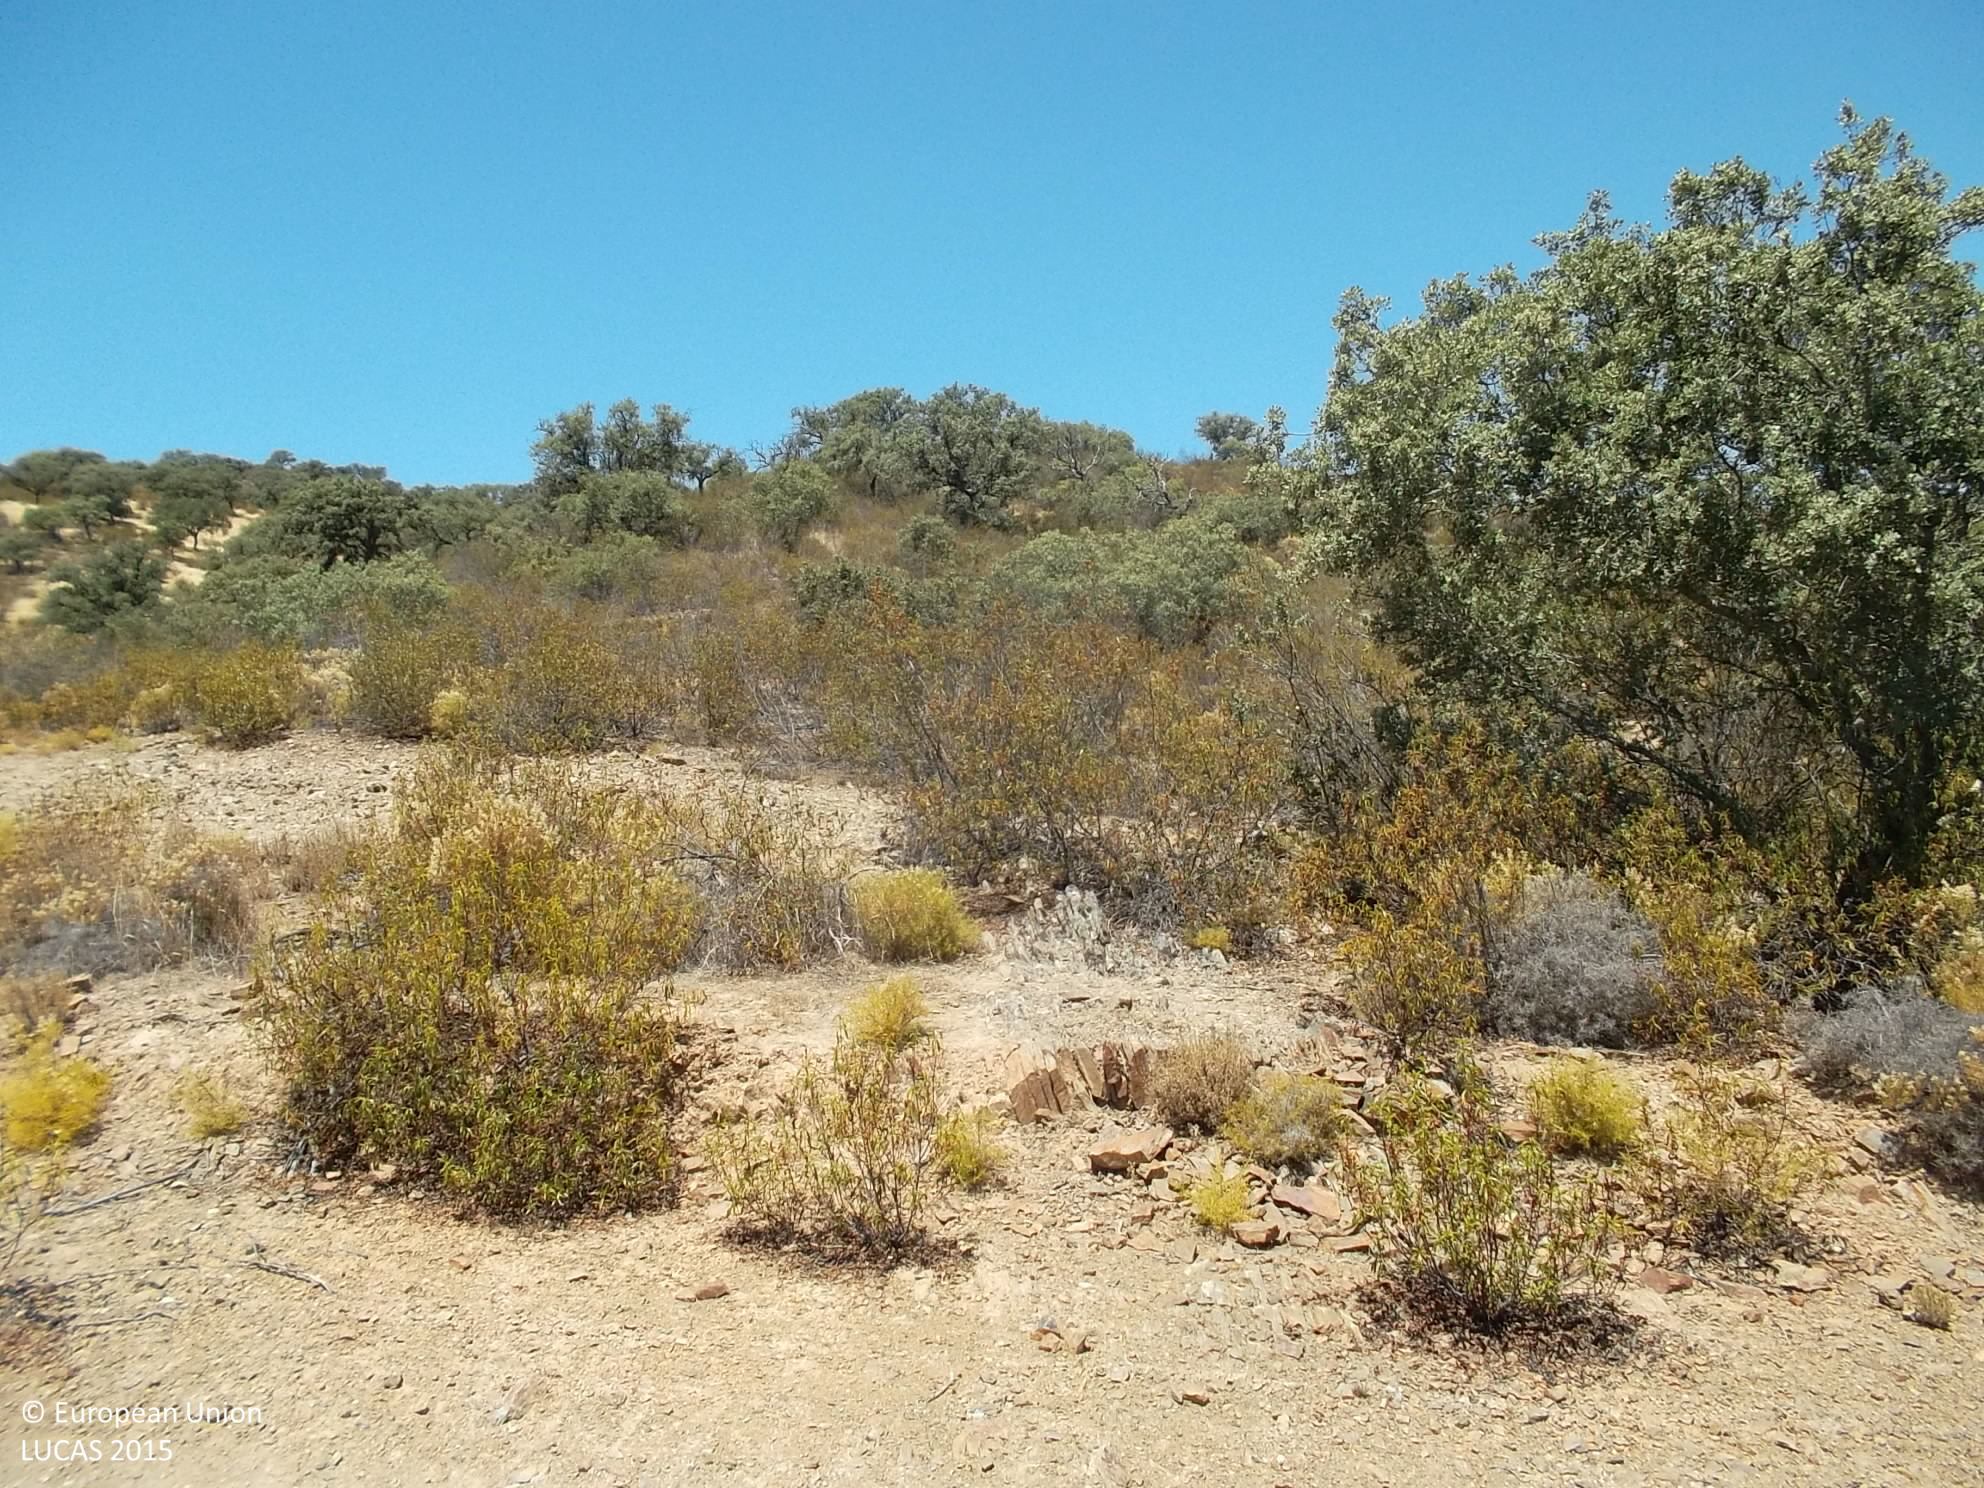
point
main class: Woodland
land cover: Broadleaved woodland
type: broadleaved evergreen forest
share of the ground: 25 - 50 %
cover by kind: shrubs 70 %, broadleaved forest trees 30 %
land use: Forestry
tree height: > 5 m
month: July
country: ES
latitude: 38.1871
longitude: -5.6859
